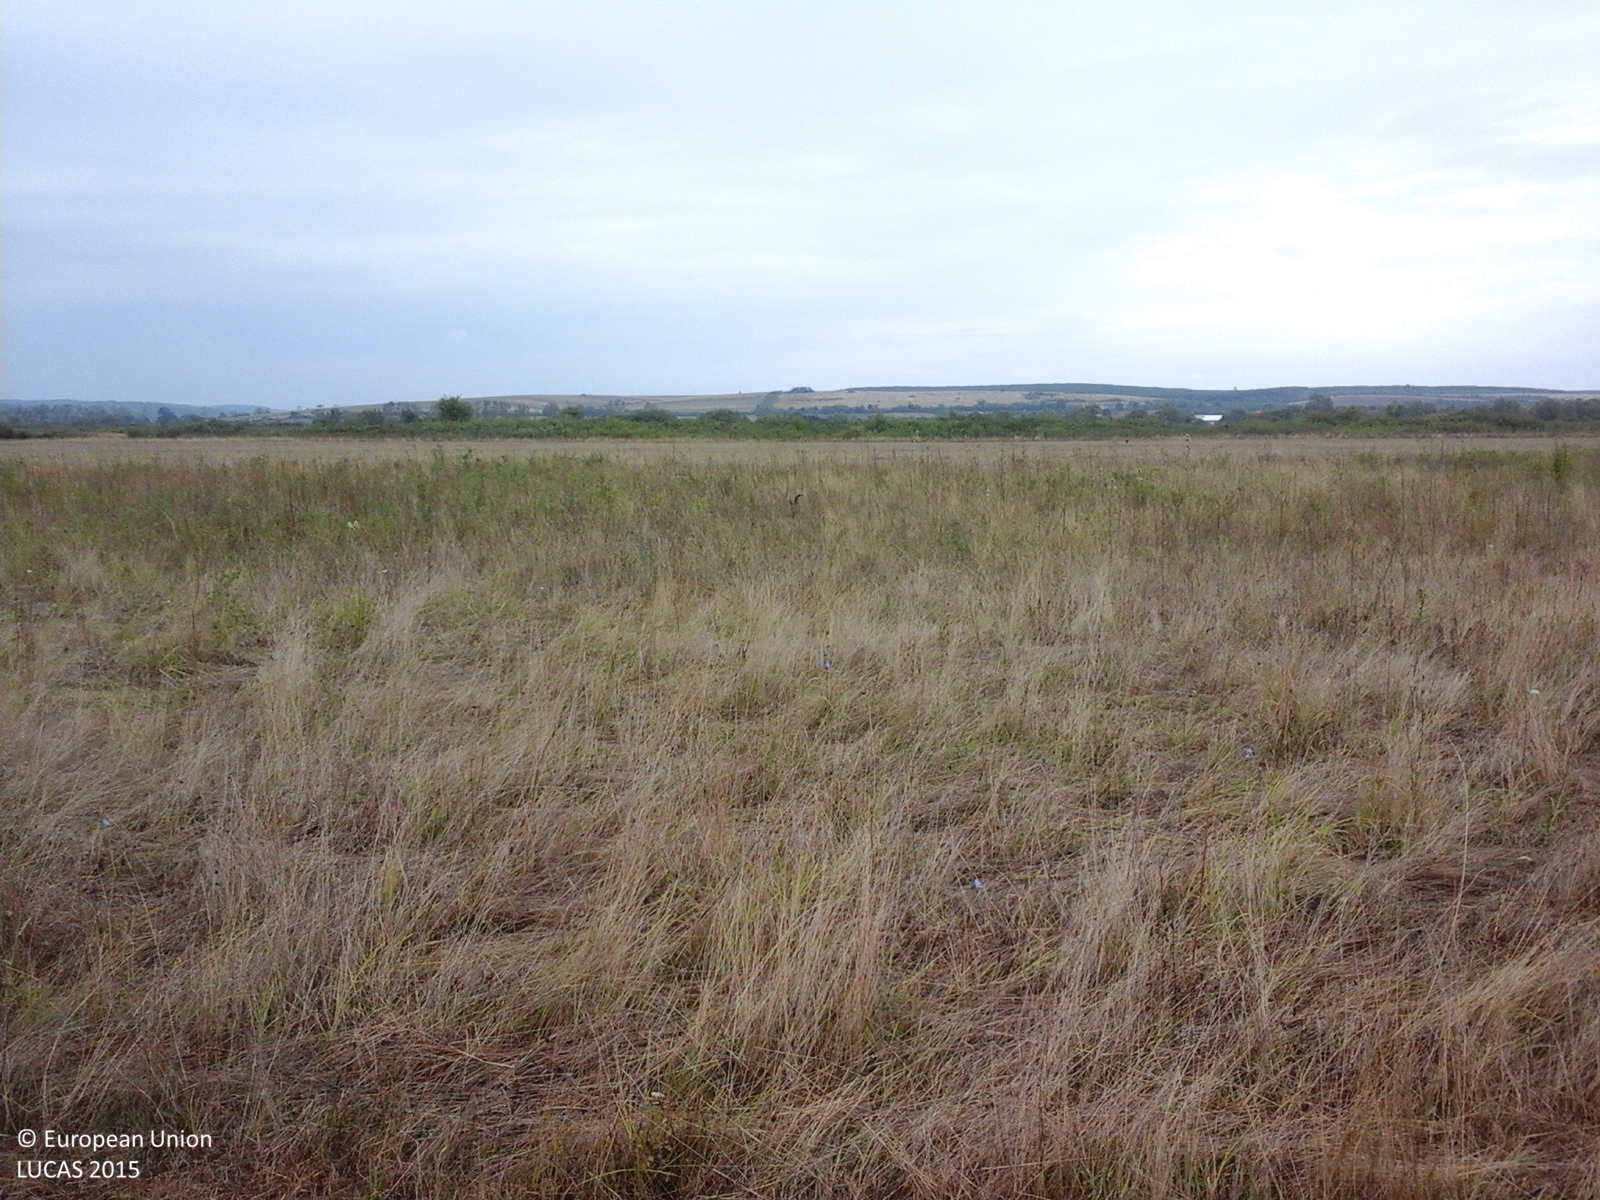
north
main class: Grassland
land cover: Grassland without tree/shrub cover
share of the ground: > 75 %
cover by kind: herbaceous plants 100 %
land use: Agriculture (excluding fallow land and kitchen gardens)
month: August
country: RO
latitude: 45.8120
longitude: 21.7348
